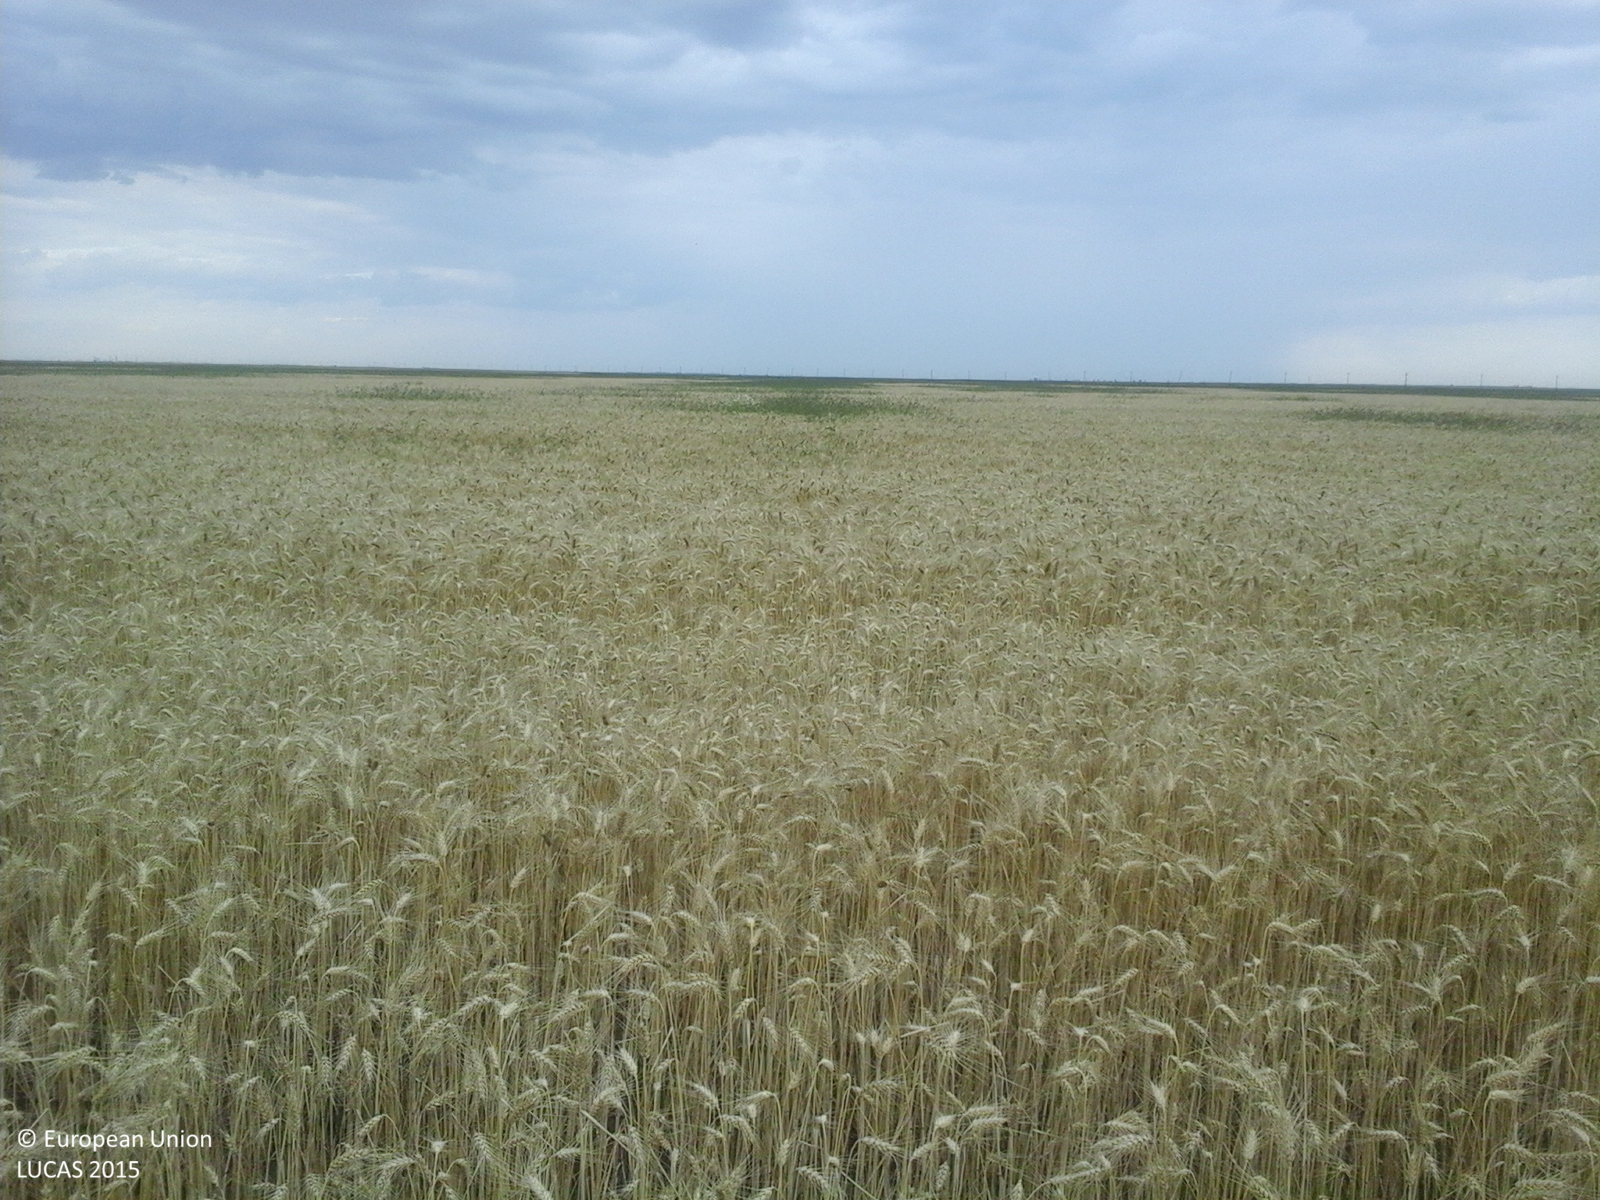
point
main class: Cropland
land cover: Common wheat
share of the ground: > 75 %
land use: Agriculture (excluding fallow land and kitchen gardens)
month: July
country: RO
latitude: 44.4234
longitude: 24.8869
